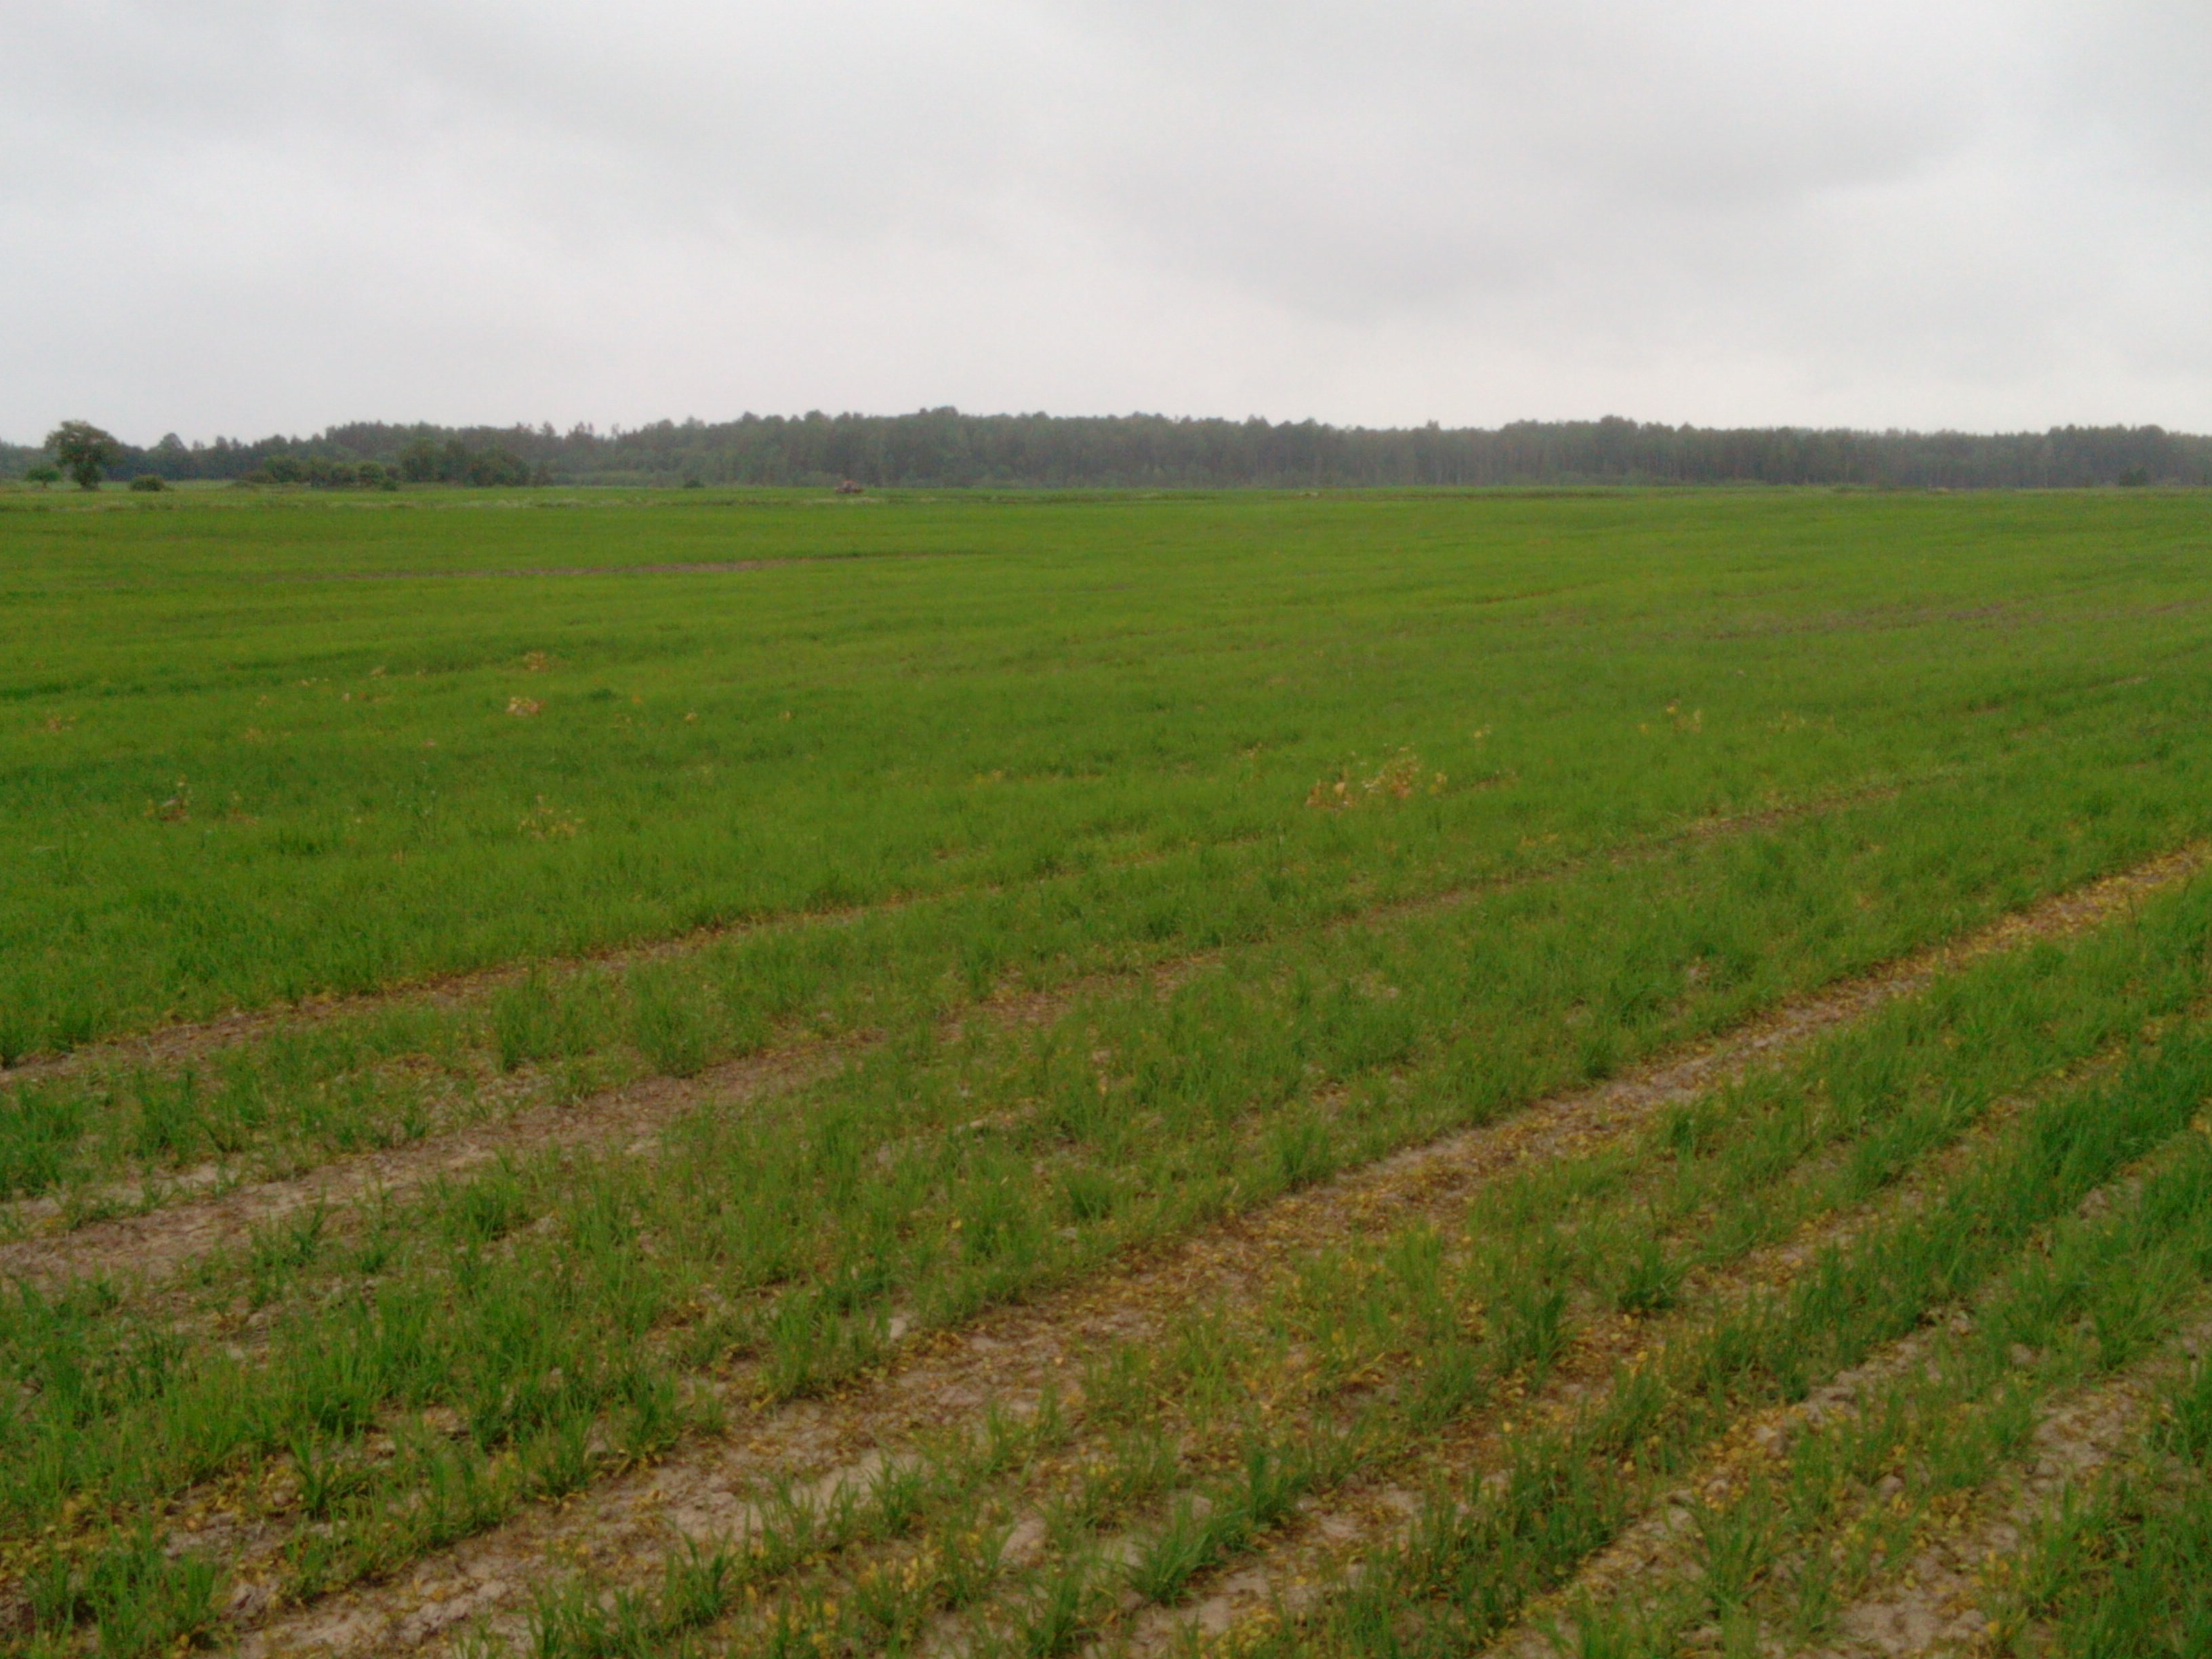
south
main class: Cropland
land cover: Barley
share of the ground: > 75 %
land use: Agriculture (excluding fallow land and kitchen gardens)
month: June
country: LV
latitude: 56.6647
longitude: 22.1411
